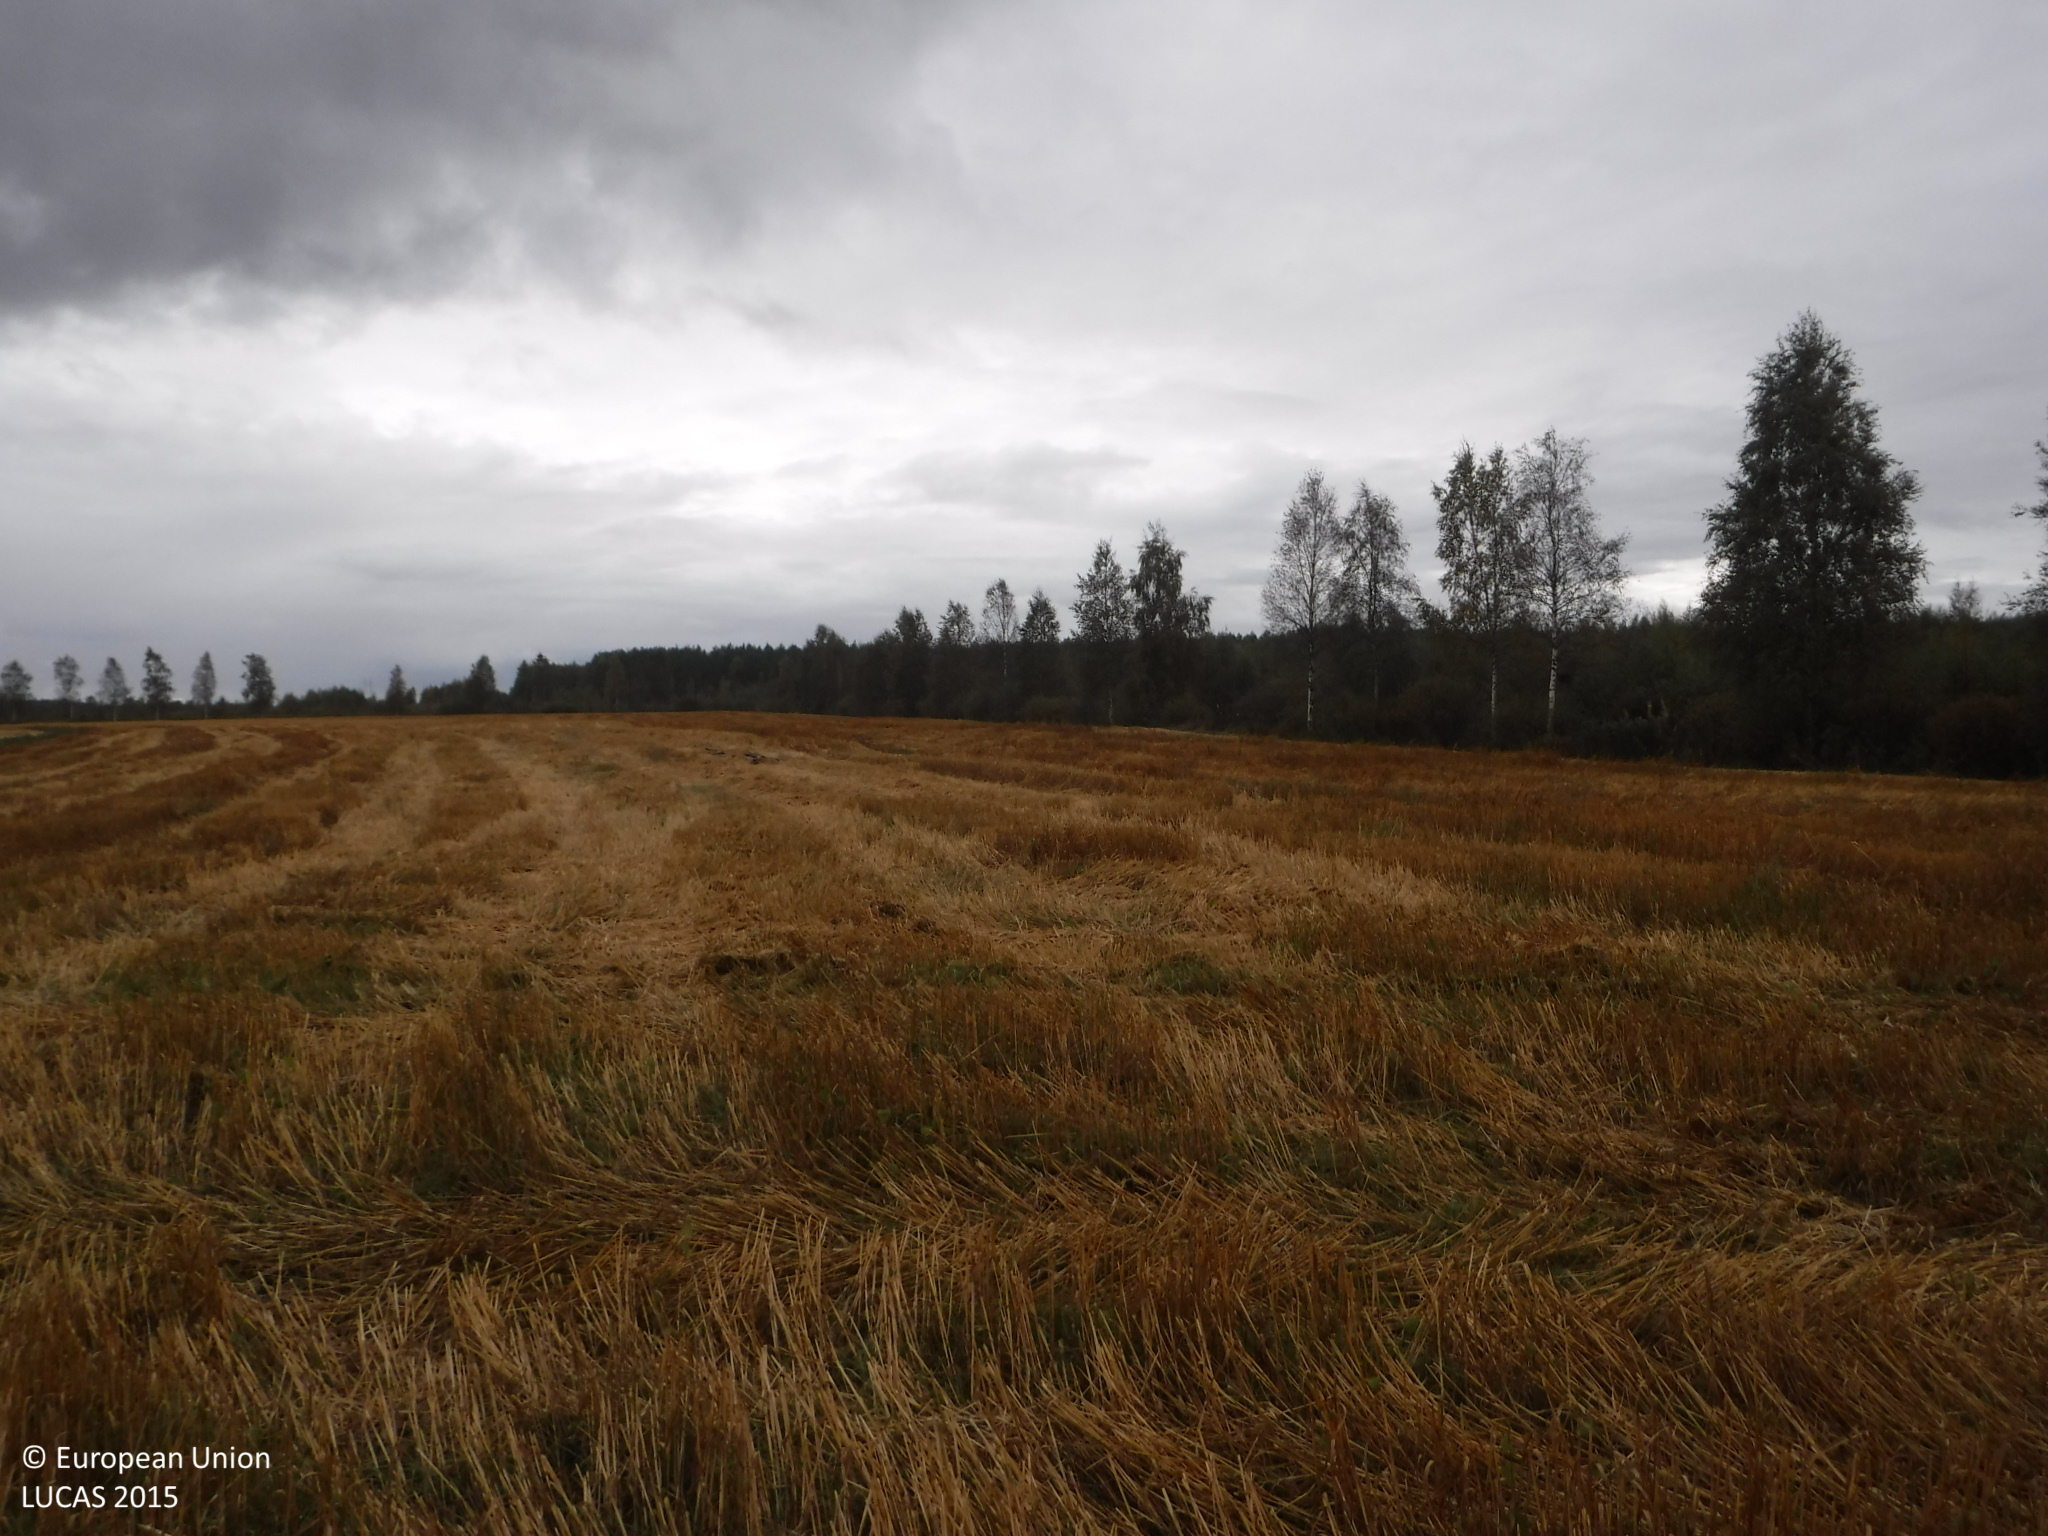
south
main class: Cropland
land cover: Oats
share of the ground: > 75 %
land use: Agriculture (excluding fallow land and kitchen gardens)
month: September
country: FI
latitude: 62.0289
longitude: 22.3463
